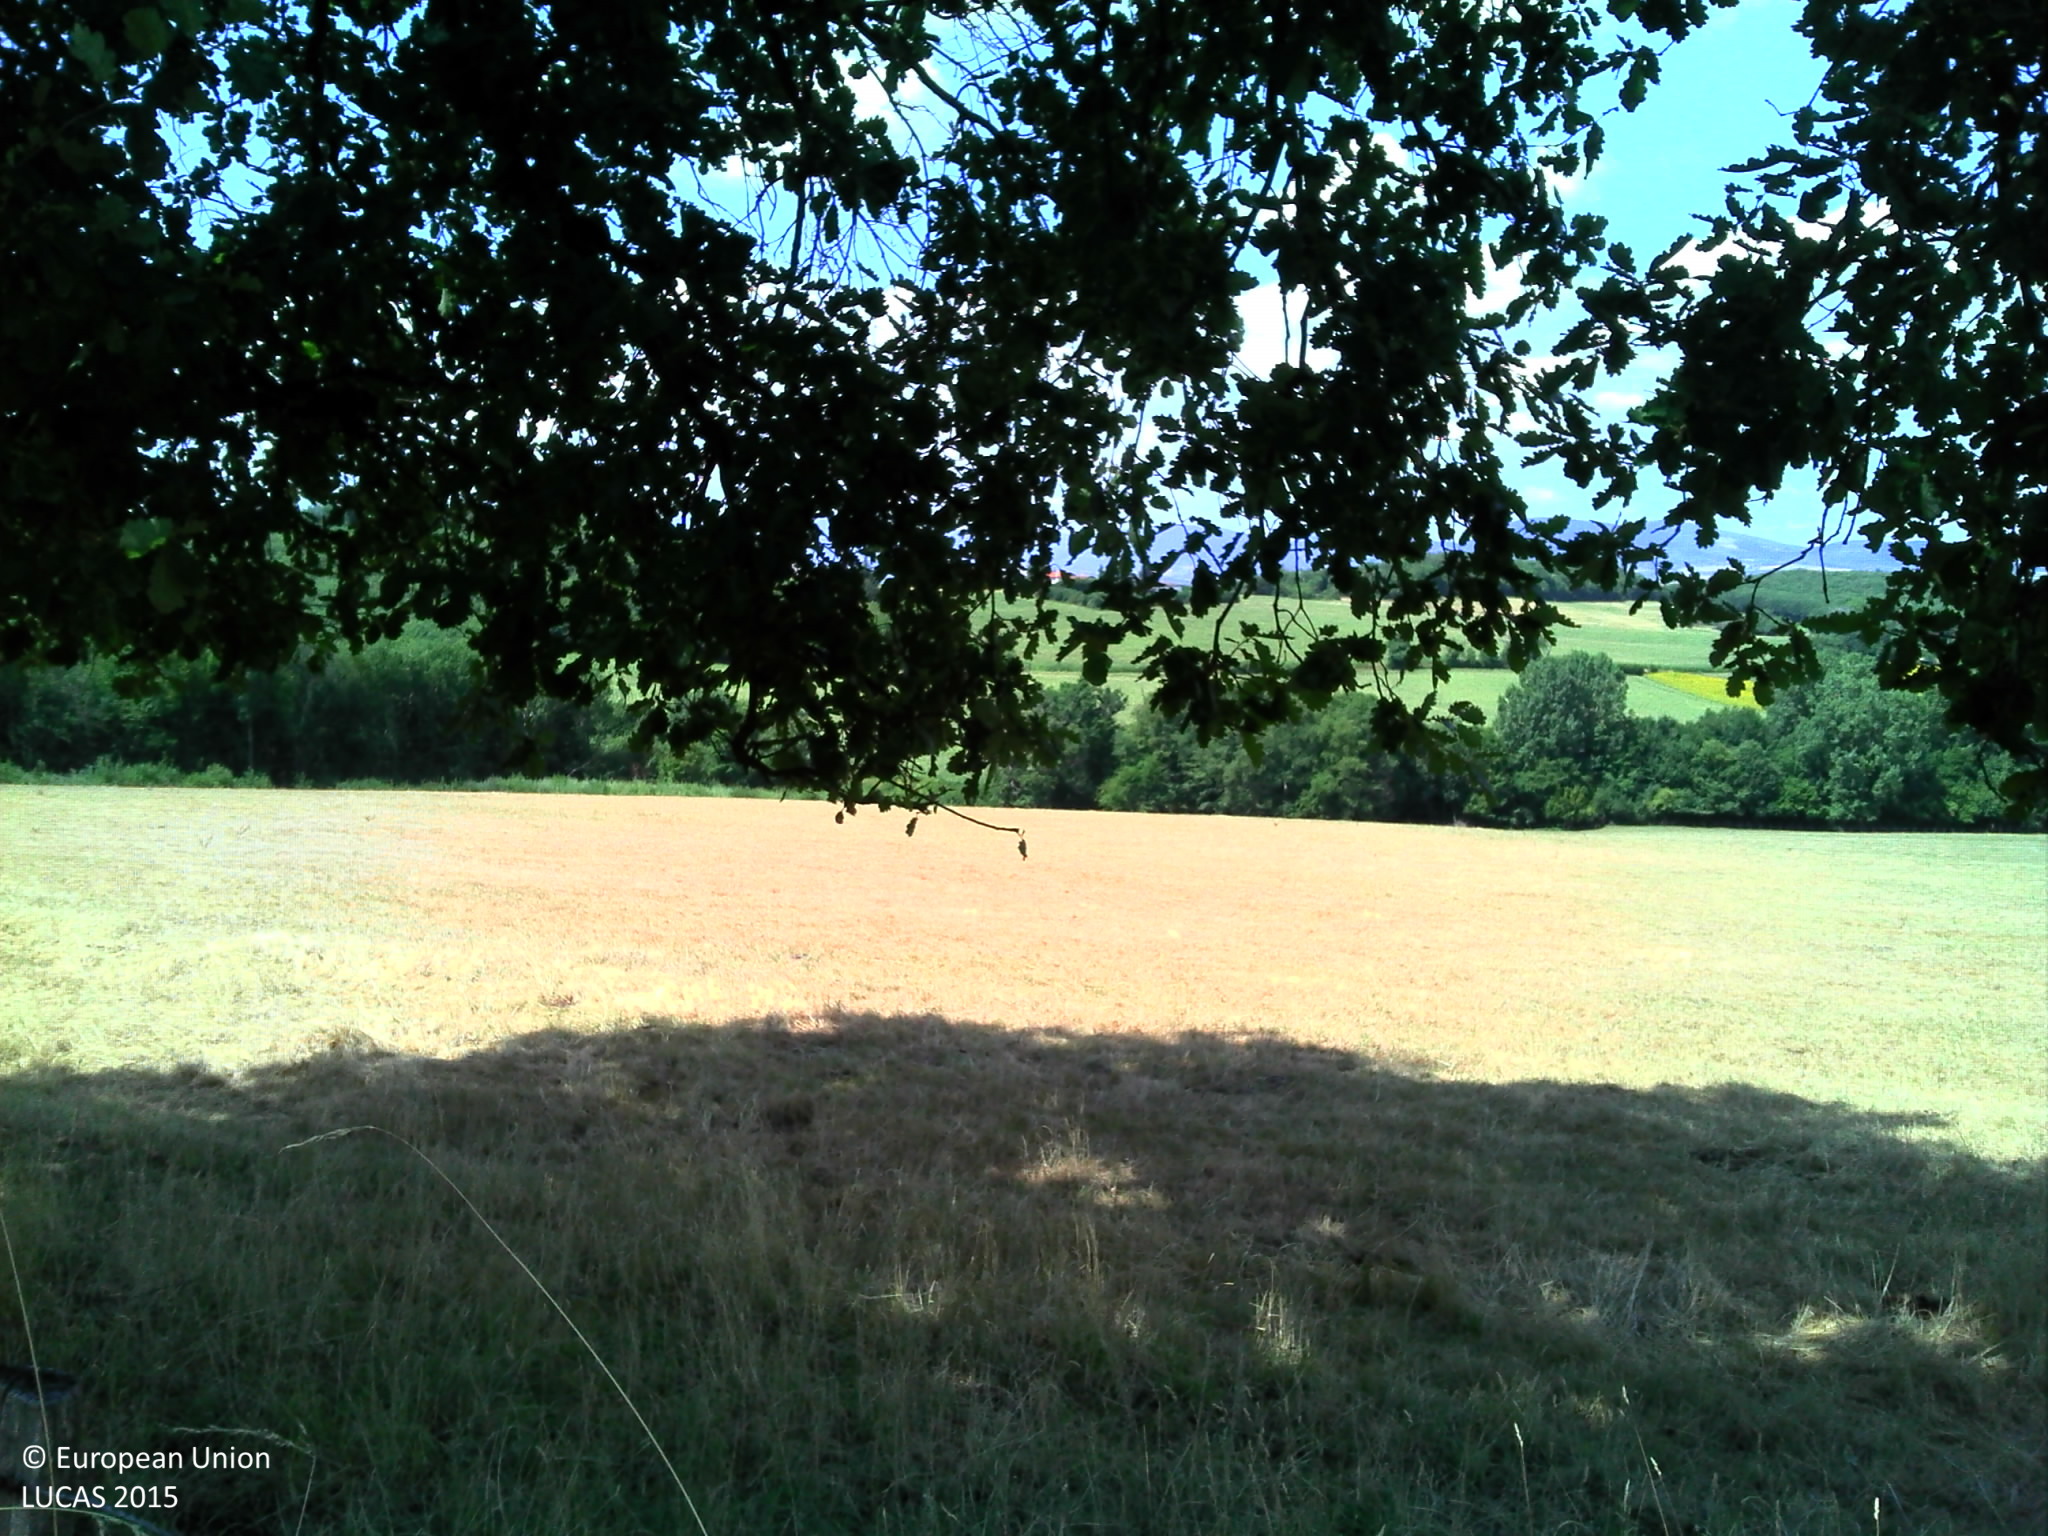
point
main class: Grassland
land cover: Grassland without tree/shrub cover
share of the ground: > 75 %
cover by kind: herbaceous plants 100 %
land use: Agriculture (excluding fallow land and kitchen gardens)
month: July
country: FR
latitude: 45.4882
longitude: 4.8735
